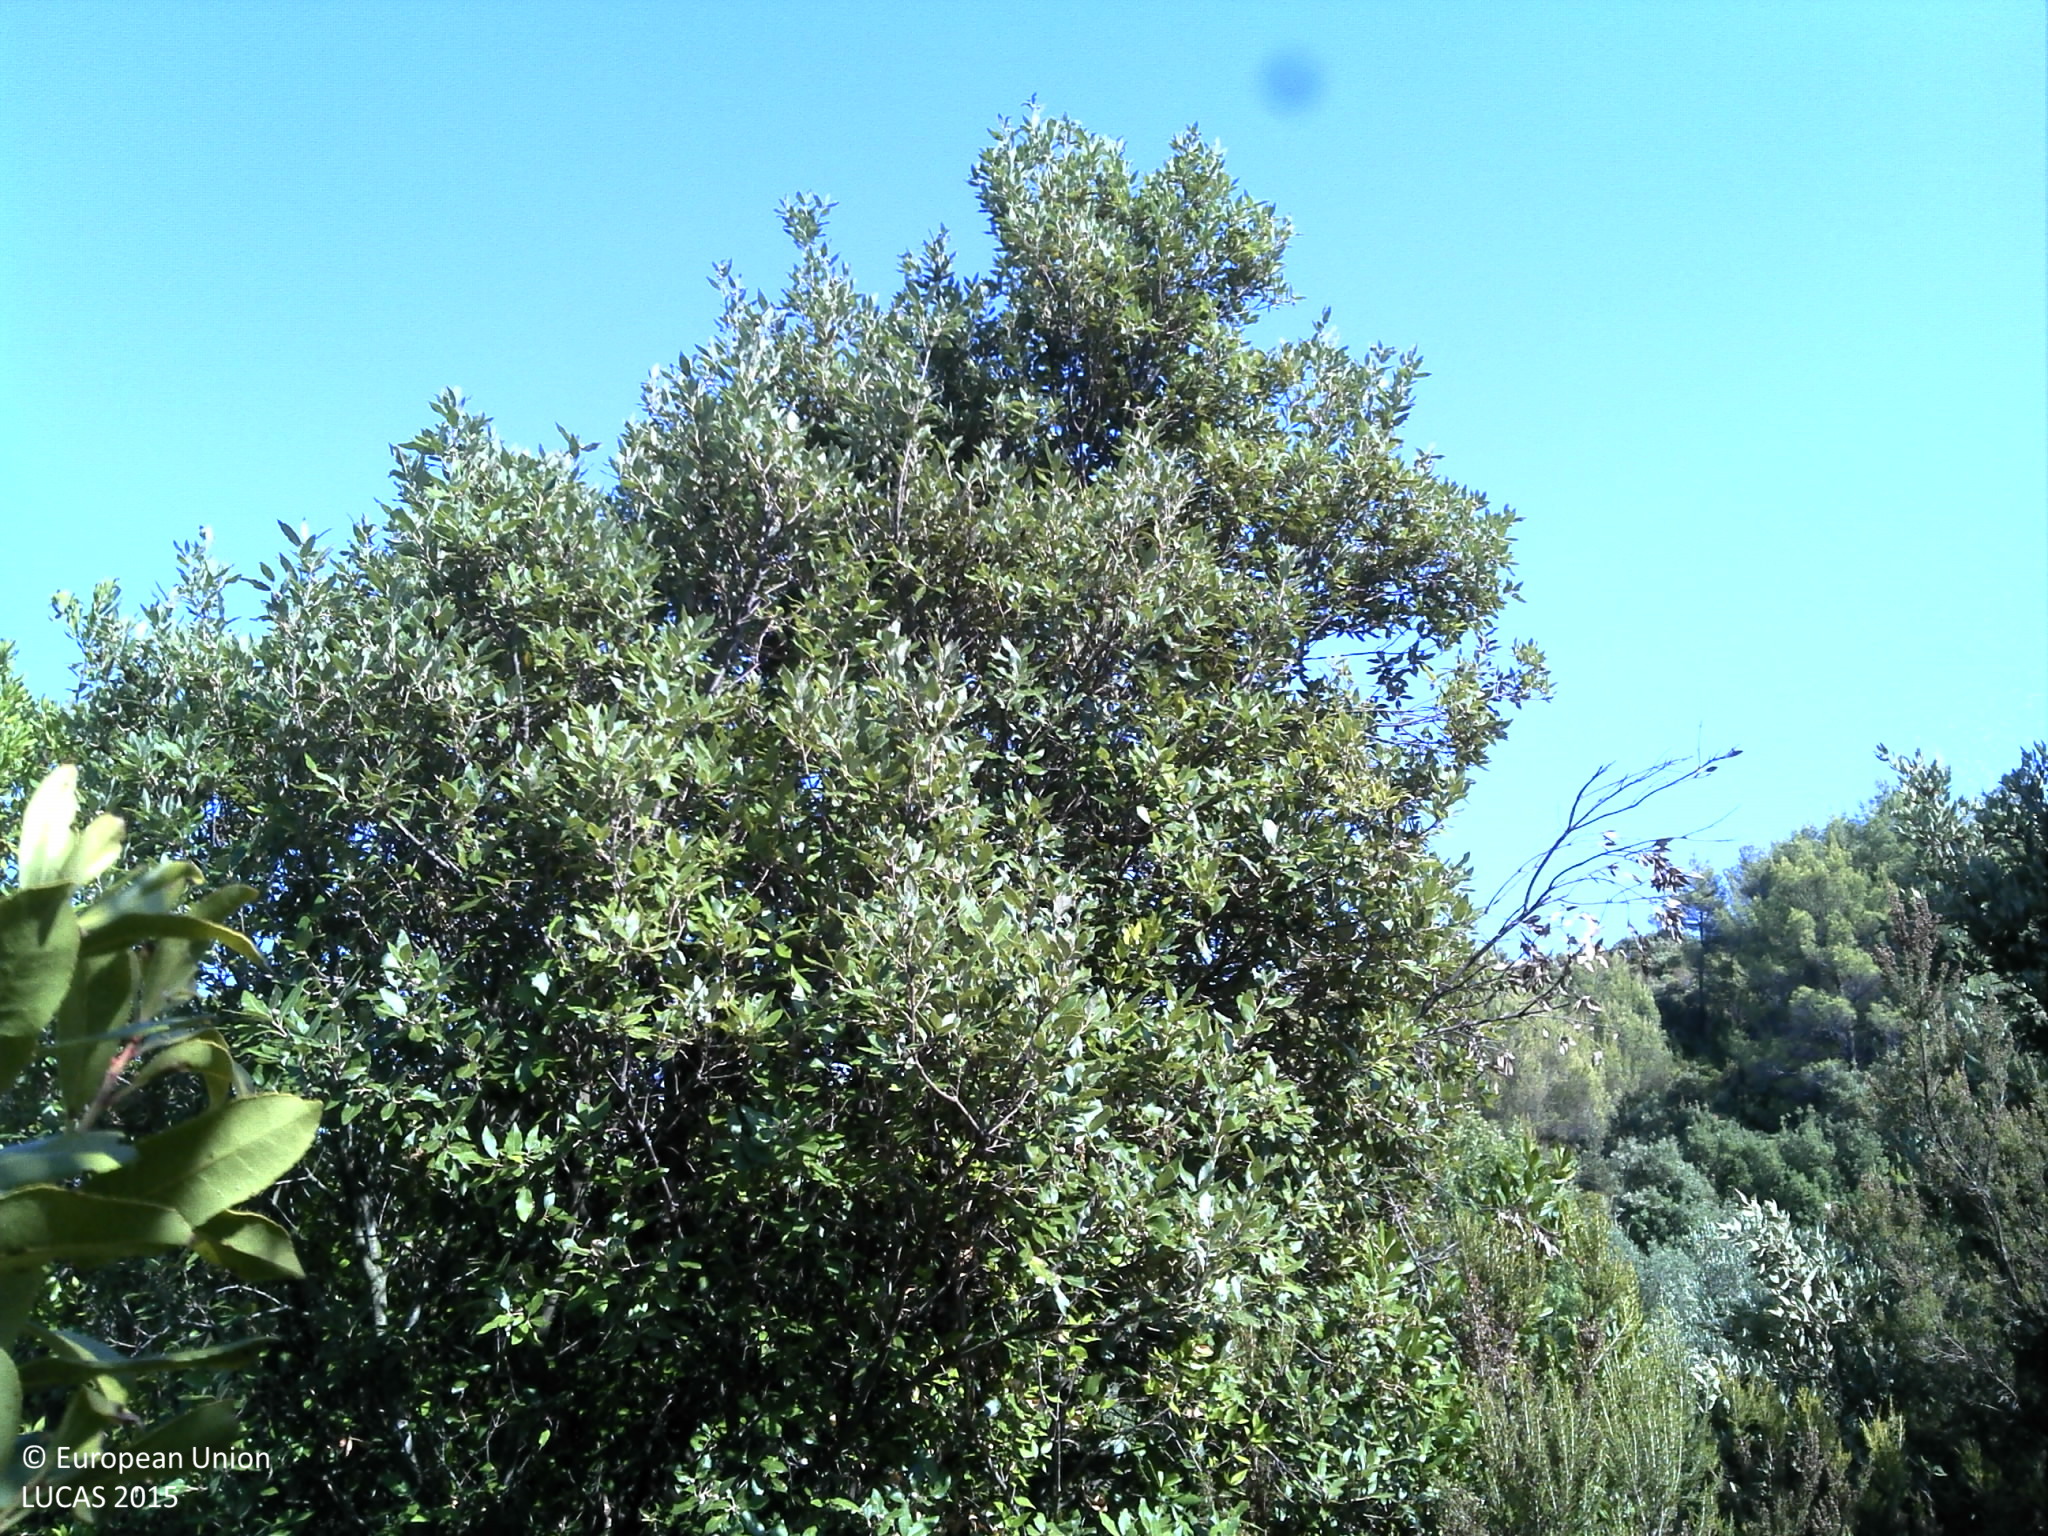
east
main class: Cropland
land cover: Olive groves
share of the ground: > 75 %
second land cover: Shrubland without tree cover
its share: > 75 %
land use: Agriculture (excluding fallow land and kitchen gardens)
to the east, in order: Olive groves; Shrubland without tree cover; Olive groves; Dry stone walls; Olive groves; Dry stone walls; Olive groves; Paved roads, cycling and walking lanes; Olive groves; Dry stone walls; Olive groves; Tracks; Olive groves; Tracks
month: August
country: HR
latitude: 42.9234
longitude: 16.9355
